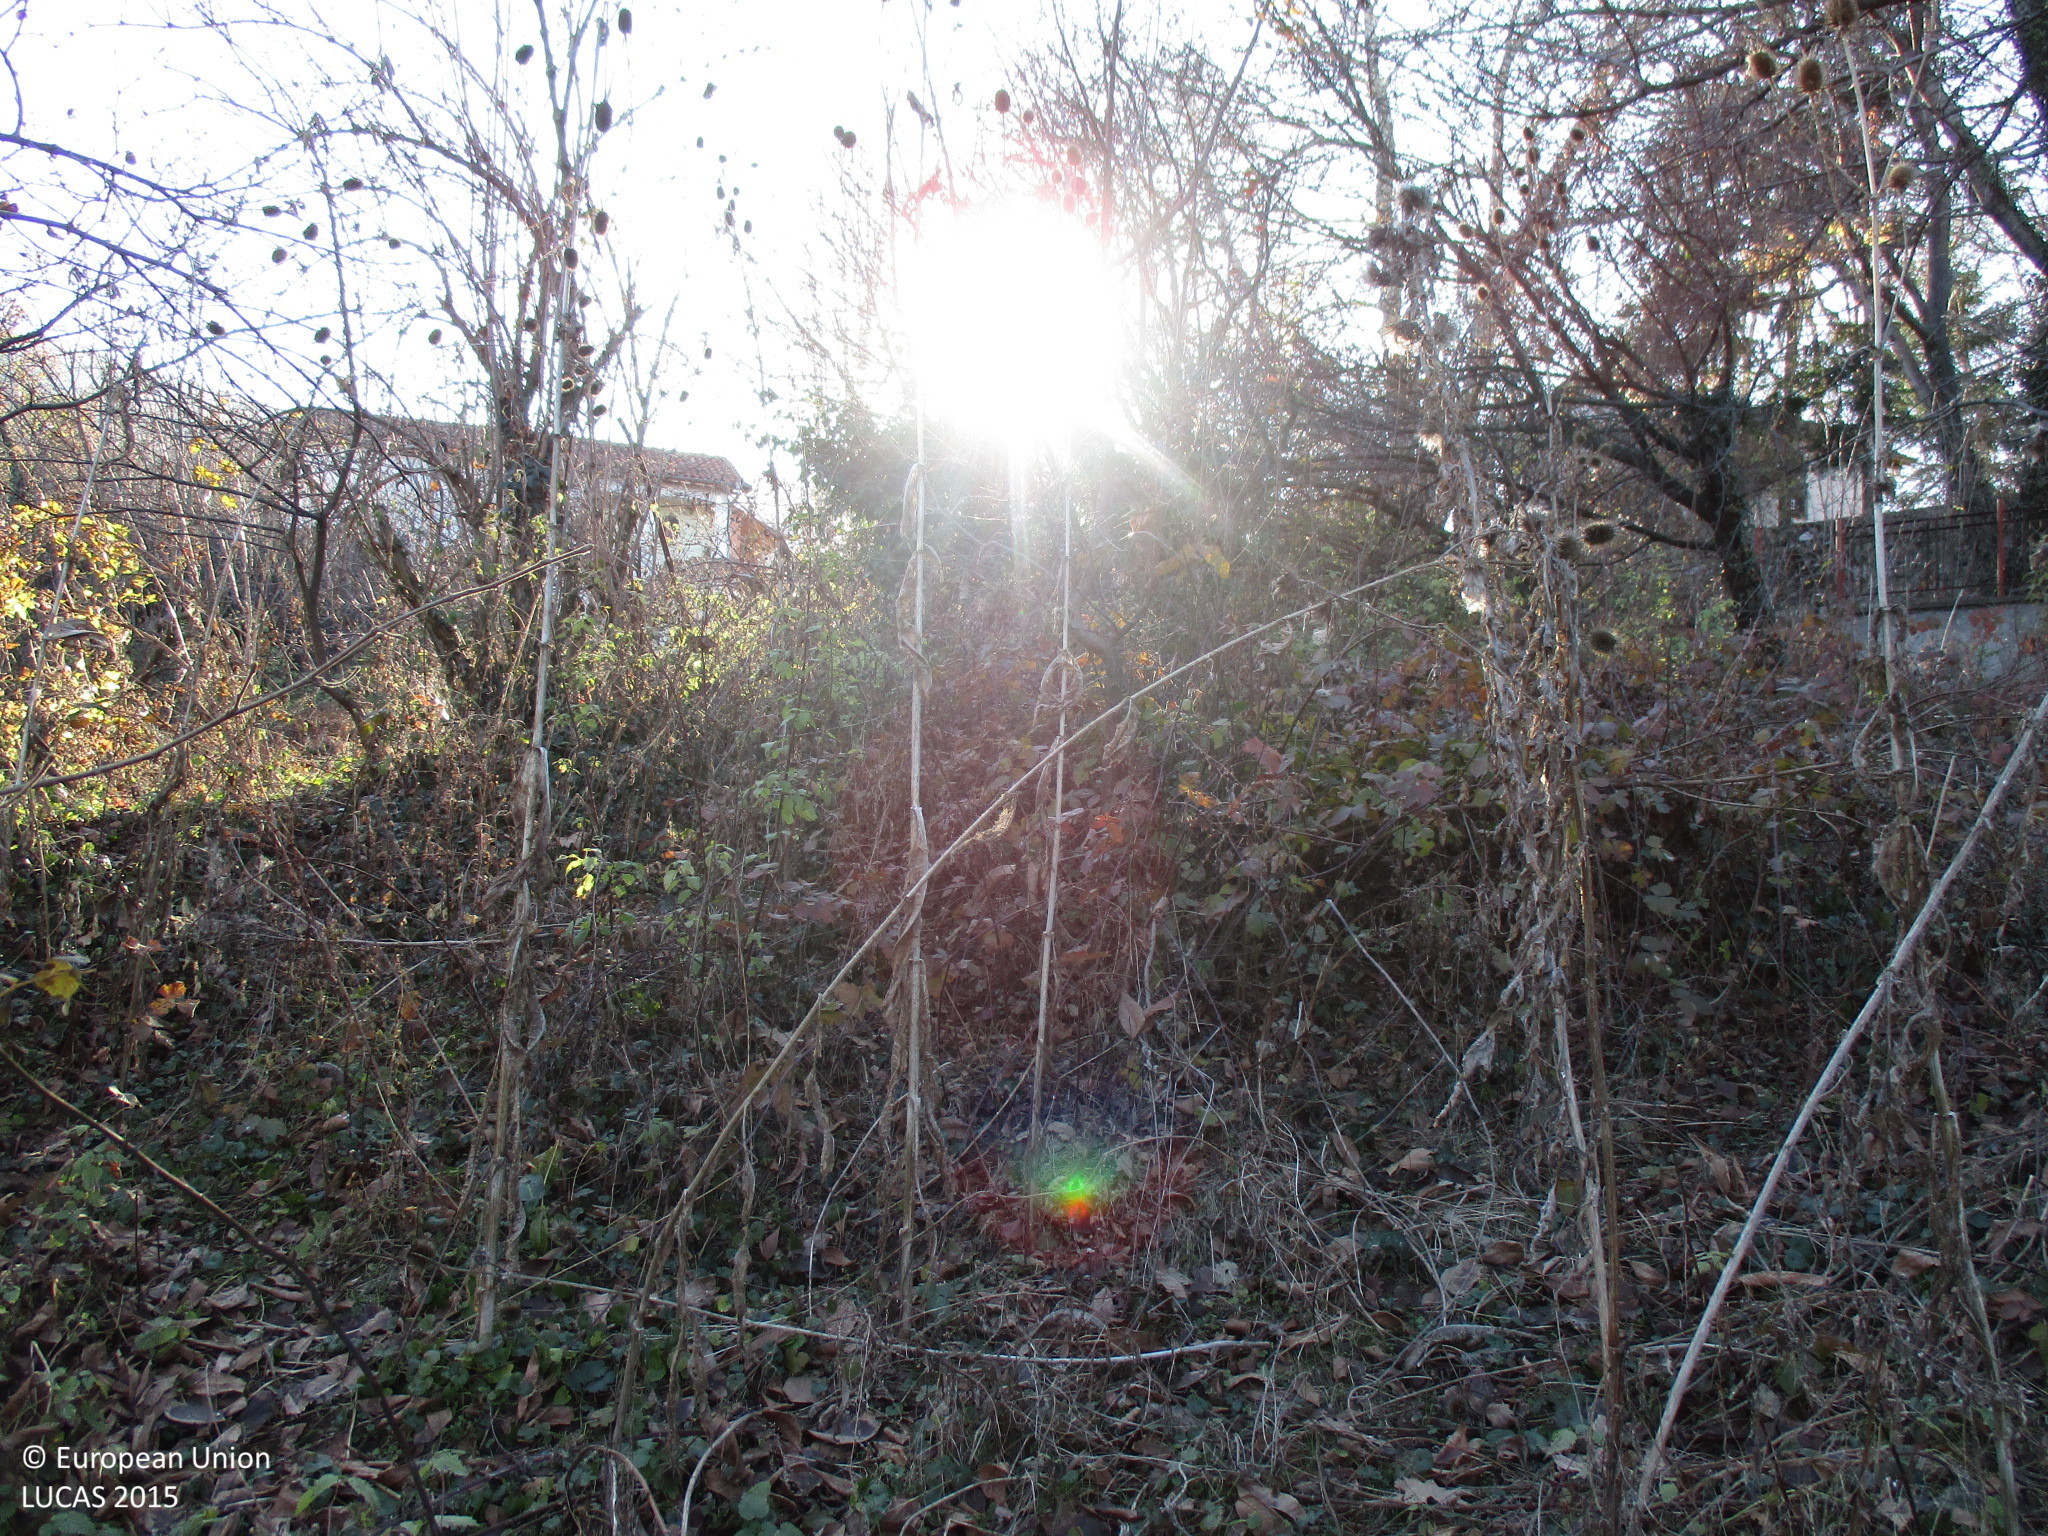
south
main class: Woodland
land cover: Broadleaved woodland
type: mesophytic deciduous forest
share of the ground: > 75 %
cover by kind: broadleaved forest trees 90 %, shrubs 10 %
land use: Semi-natural and natural areas not in use
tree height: > 5 m
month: December
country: BG
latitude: 42.0363
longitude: 24.6774
